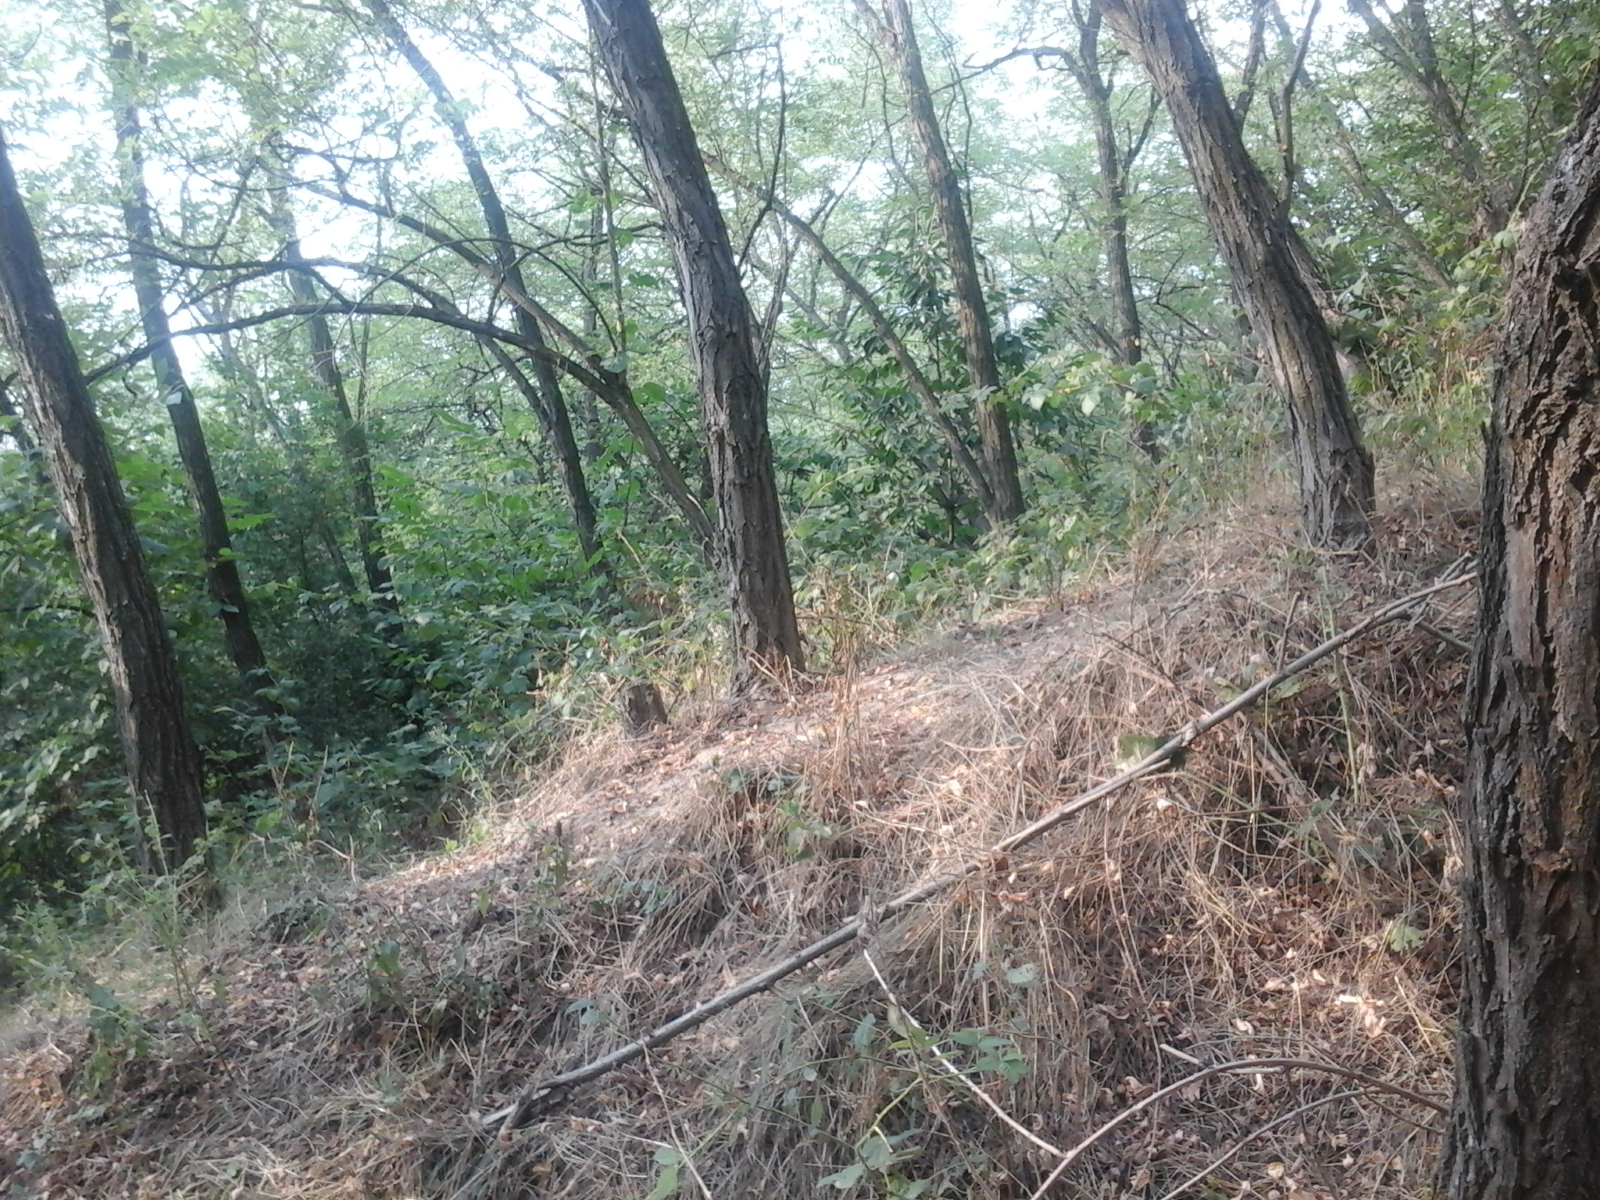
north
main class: Woodland
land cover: Broadleaved woodland
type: beech forest
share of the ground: > 75 %
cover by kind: broadleaved forest trees 100 %
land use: Forestry
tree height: > 5 m
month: August
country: RO
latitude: 44.7717
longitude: 23.6928
